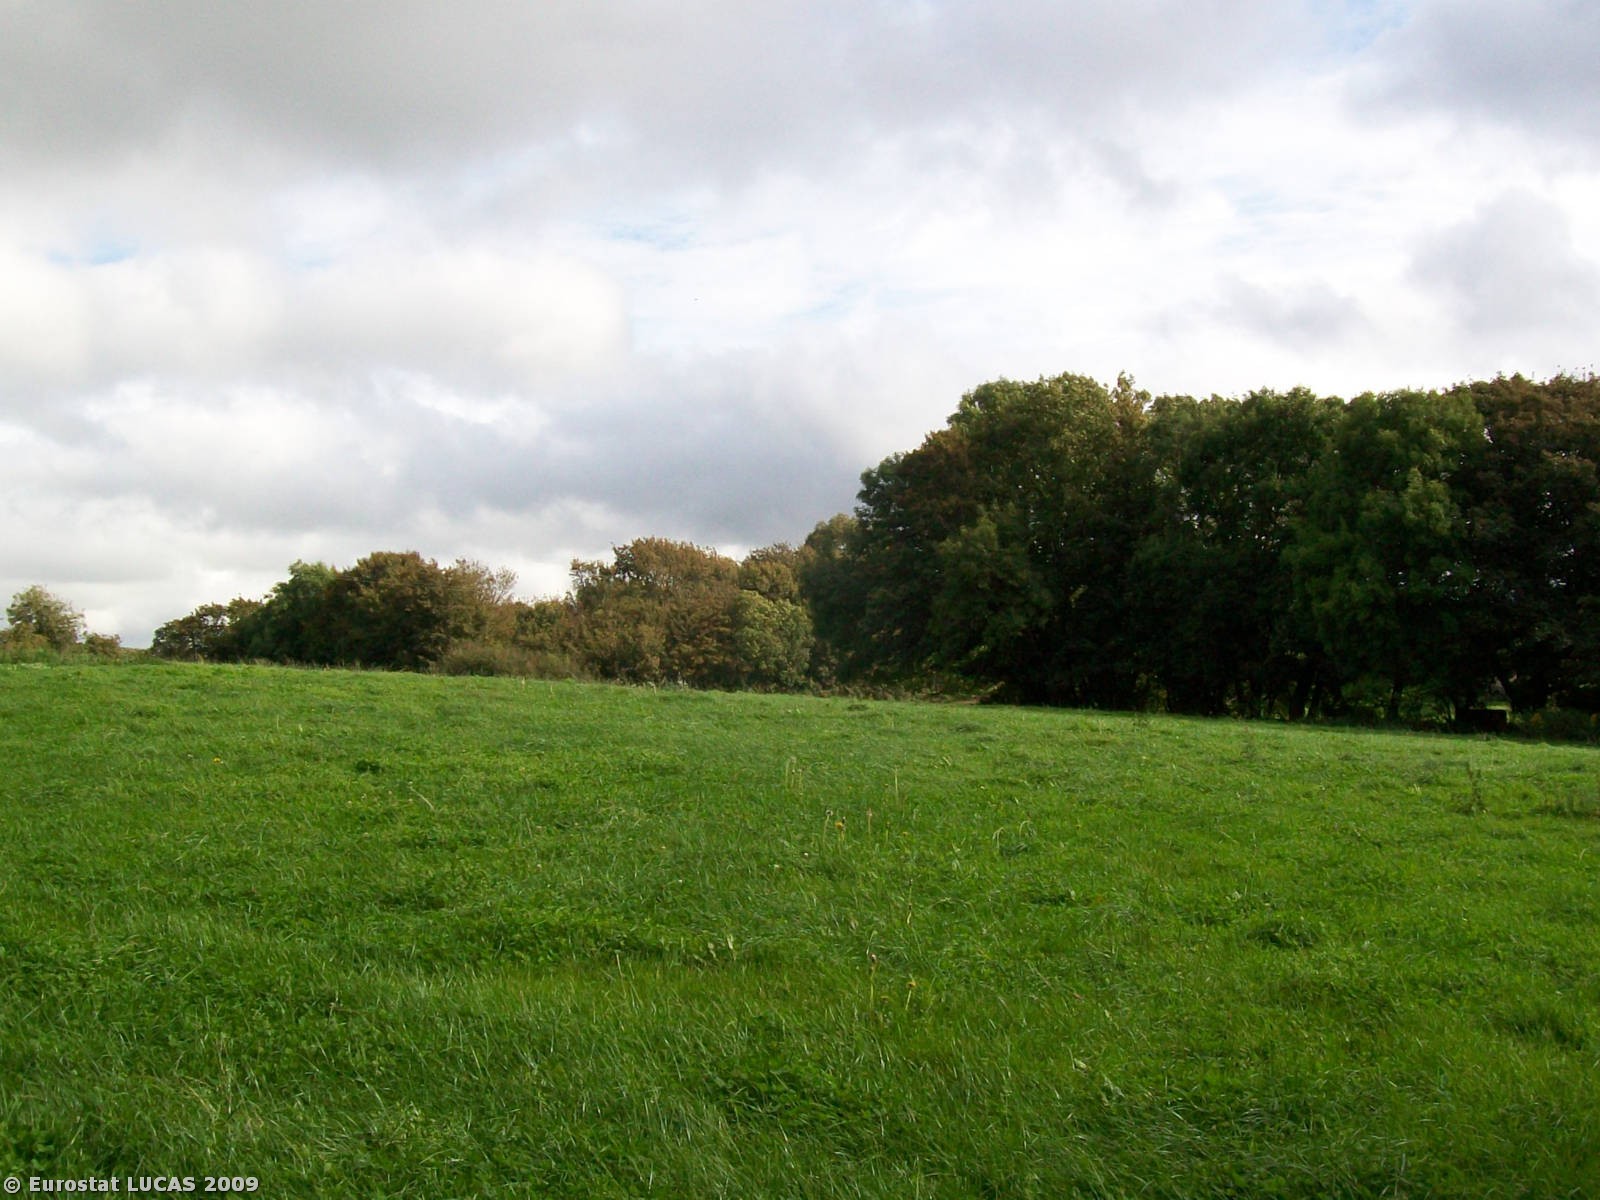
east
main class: Grassland
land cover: Grassland without tree/shrub cover
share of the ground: > 75 %
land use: Agriculture (excluding fallow land and kitchen gardens)
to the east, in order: Grassland without tree/shrub cover; Broadleaved woodland
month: September
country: GB
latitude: 52.0257
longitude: -4.8182
